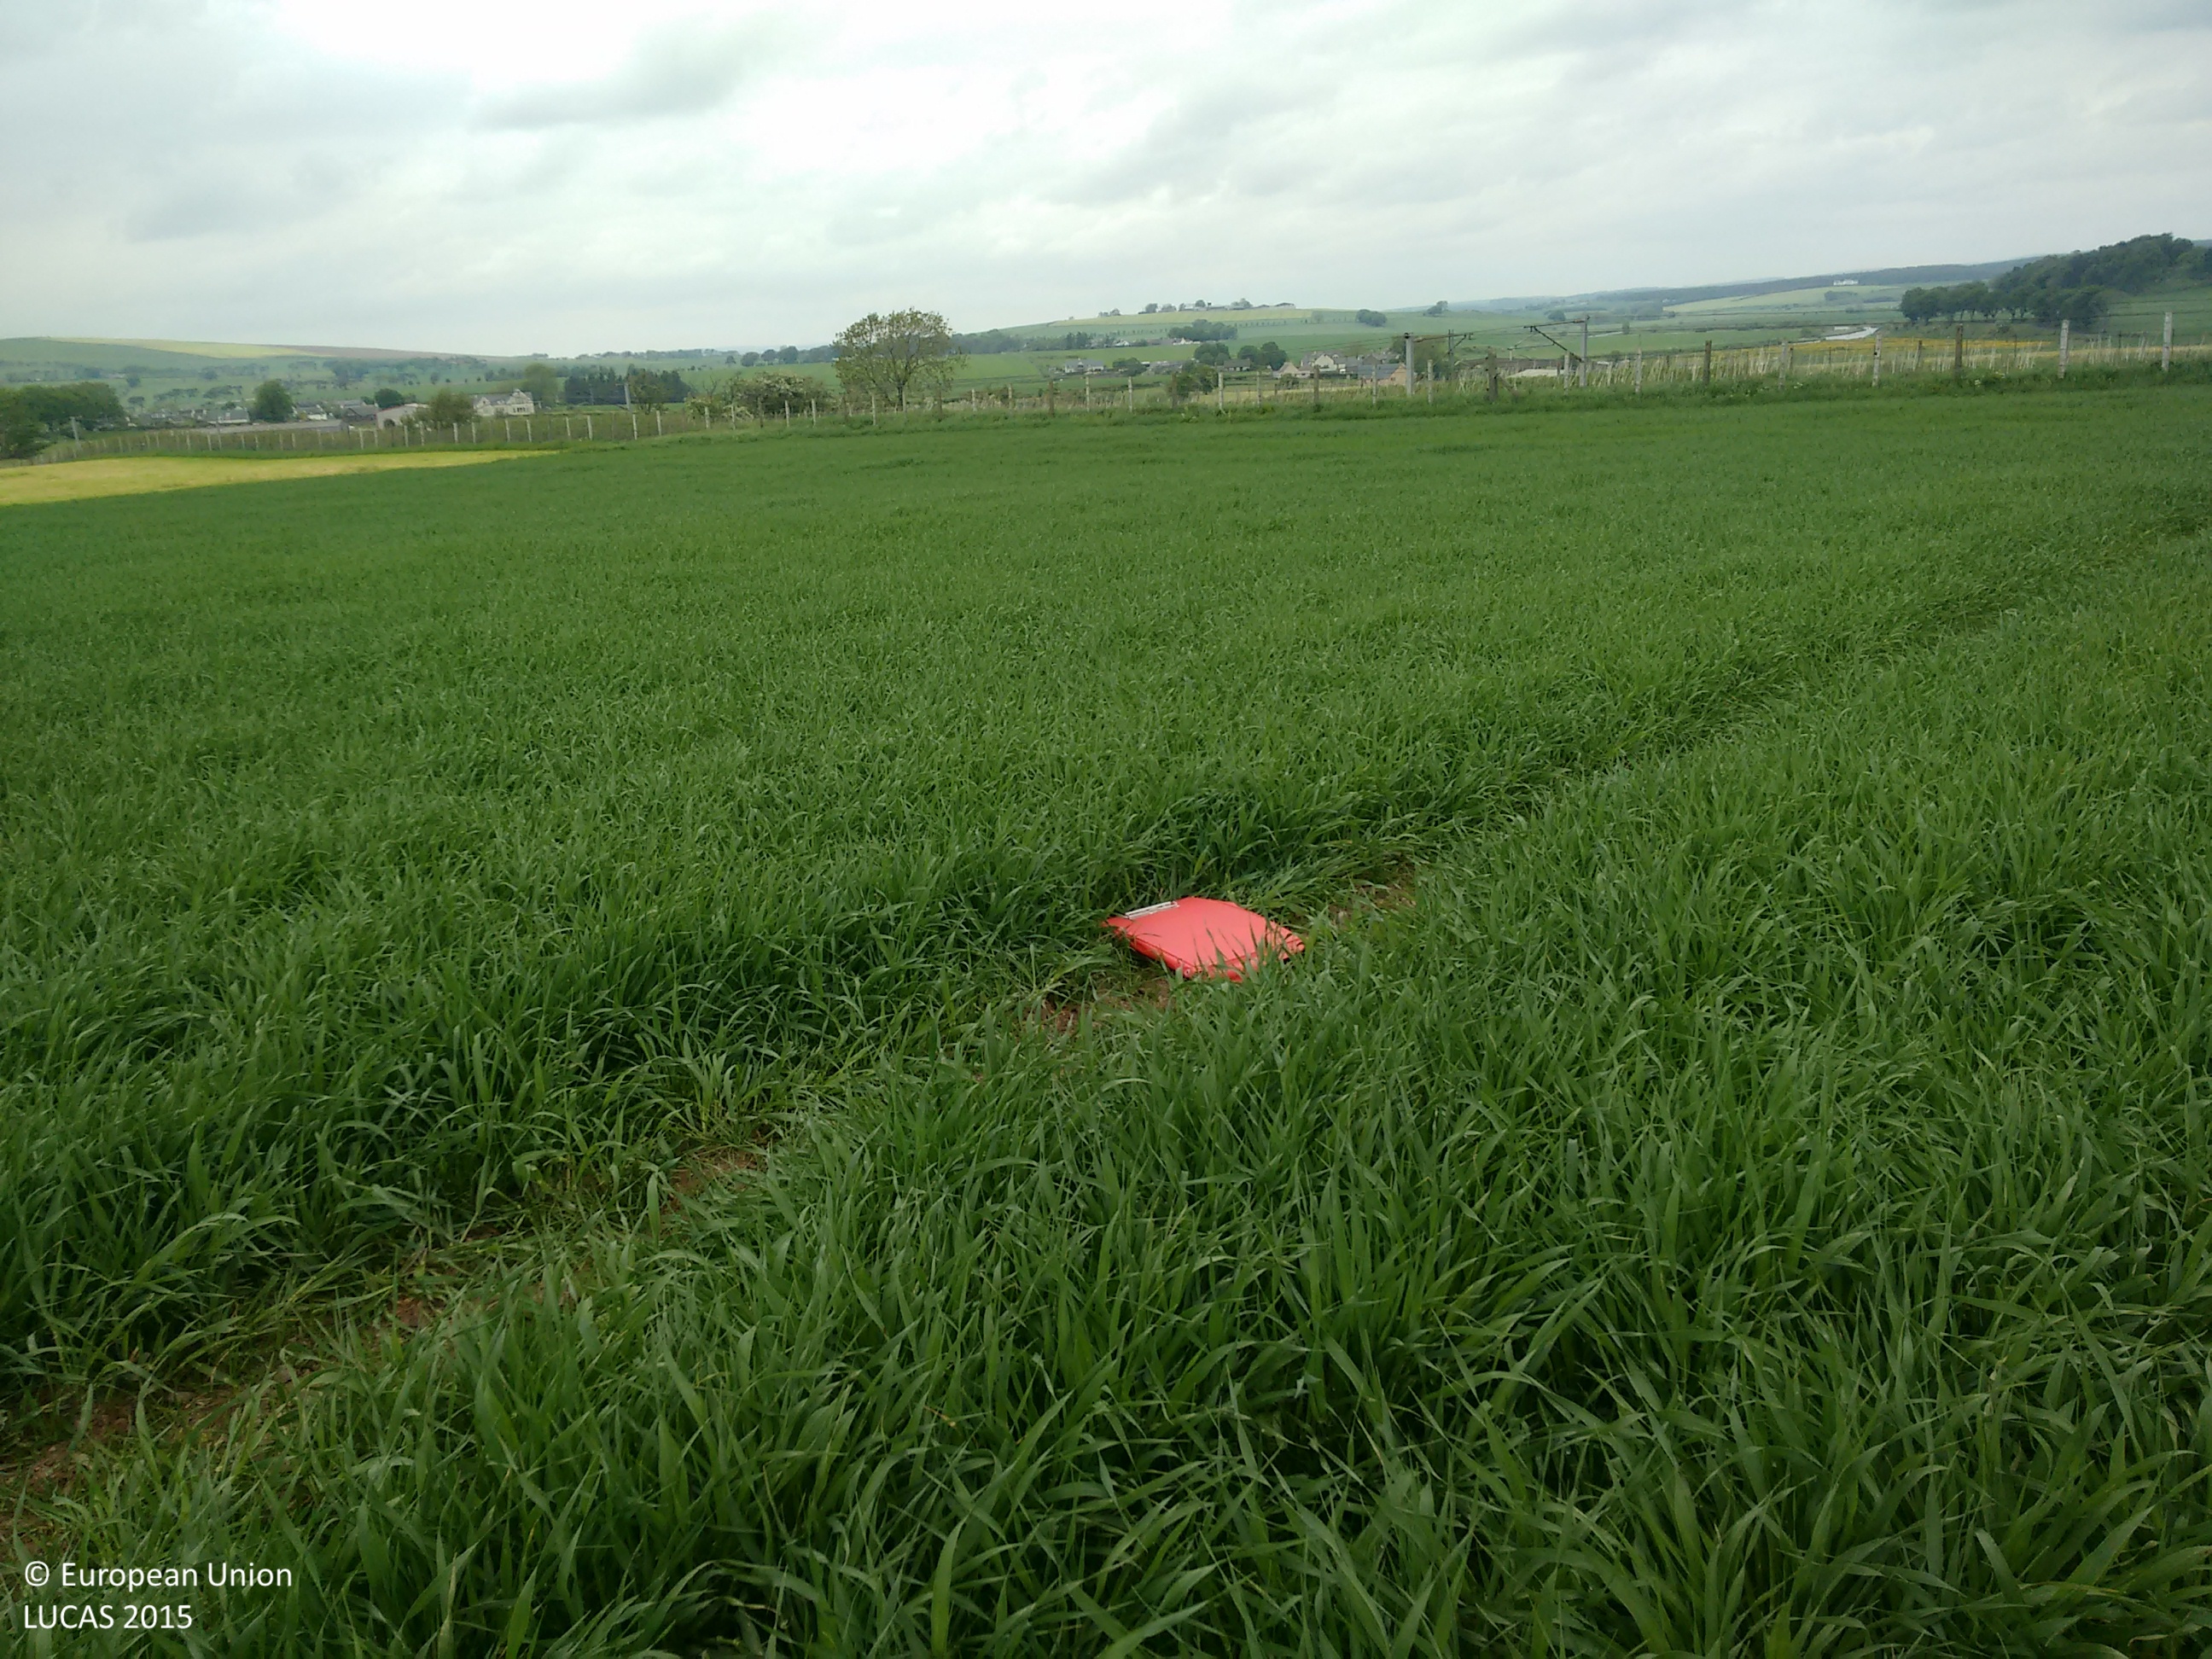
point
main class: Cropland
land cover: Barley
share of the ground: > 75 %
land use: Agriculture (excluding fallow land and kitchen gardens)
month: June
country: GB
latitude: 55.6206
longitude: -3.6262
